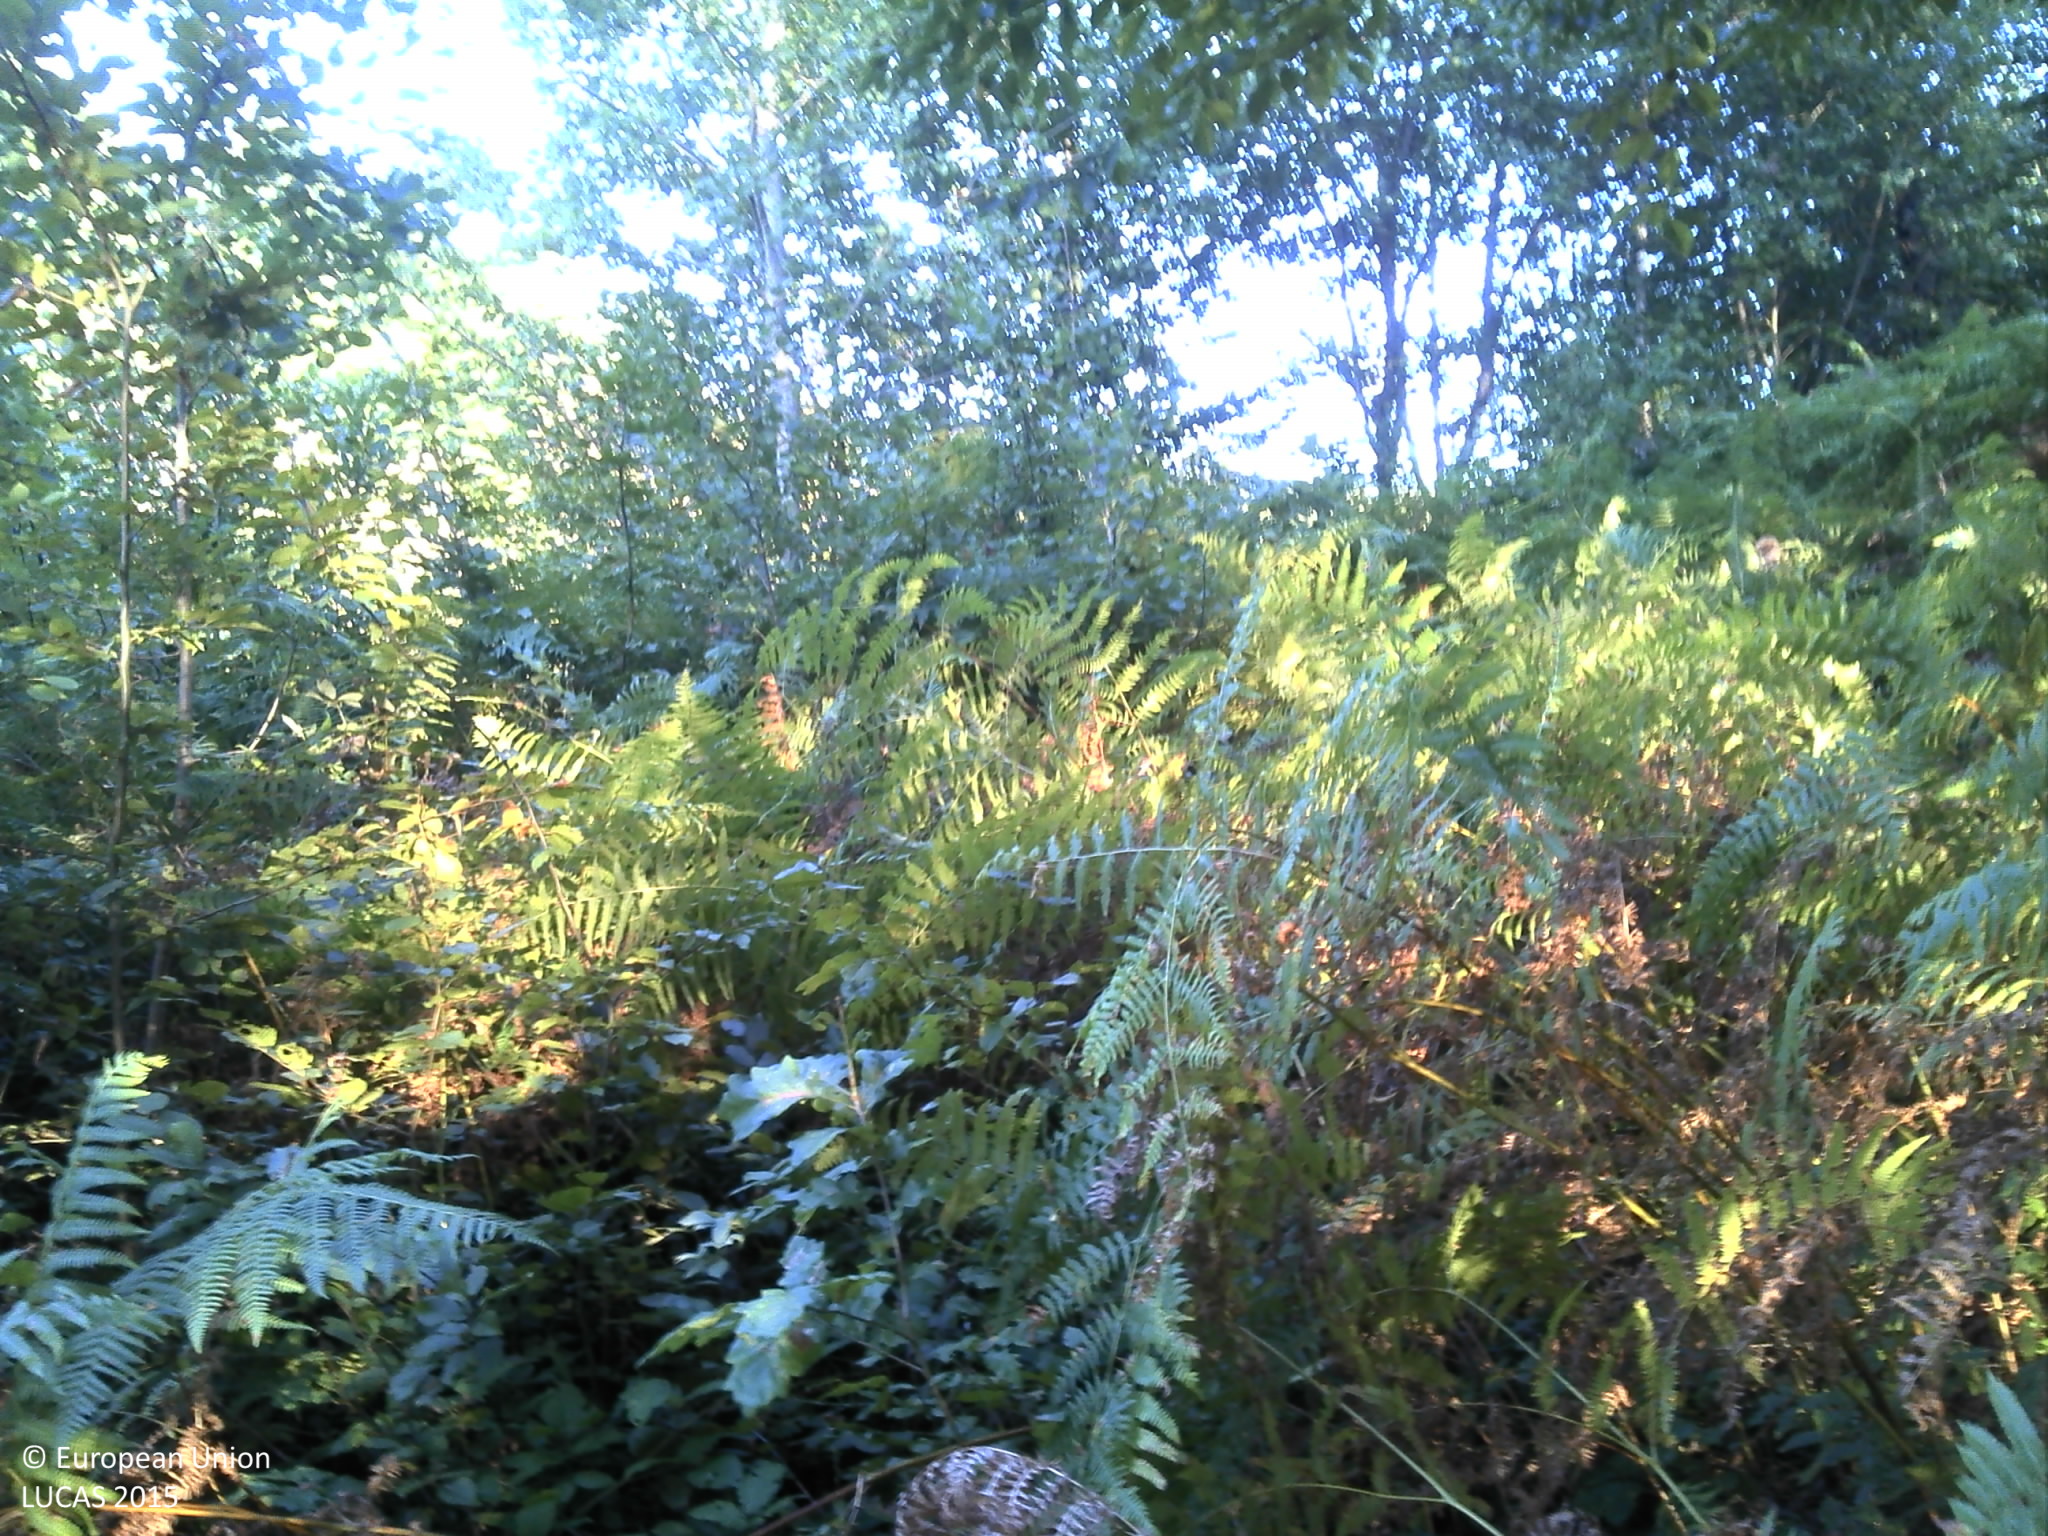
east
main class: Shrubland
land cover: Shrubland with sparse tree cover
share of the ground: > 75 %
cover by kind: shrubs 90 %, broadleaved forest trees 5 %, herbaceous plants 5 %
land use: Semi-natural and natural areas not in use
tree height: < 5 m
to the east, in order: Shrubland with sparse tree cover; Grassland without tree/shrub cover; Broadleaved woodland
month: August
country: HR
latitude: 45.2976
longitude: 16.3093
